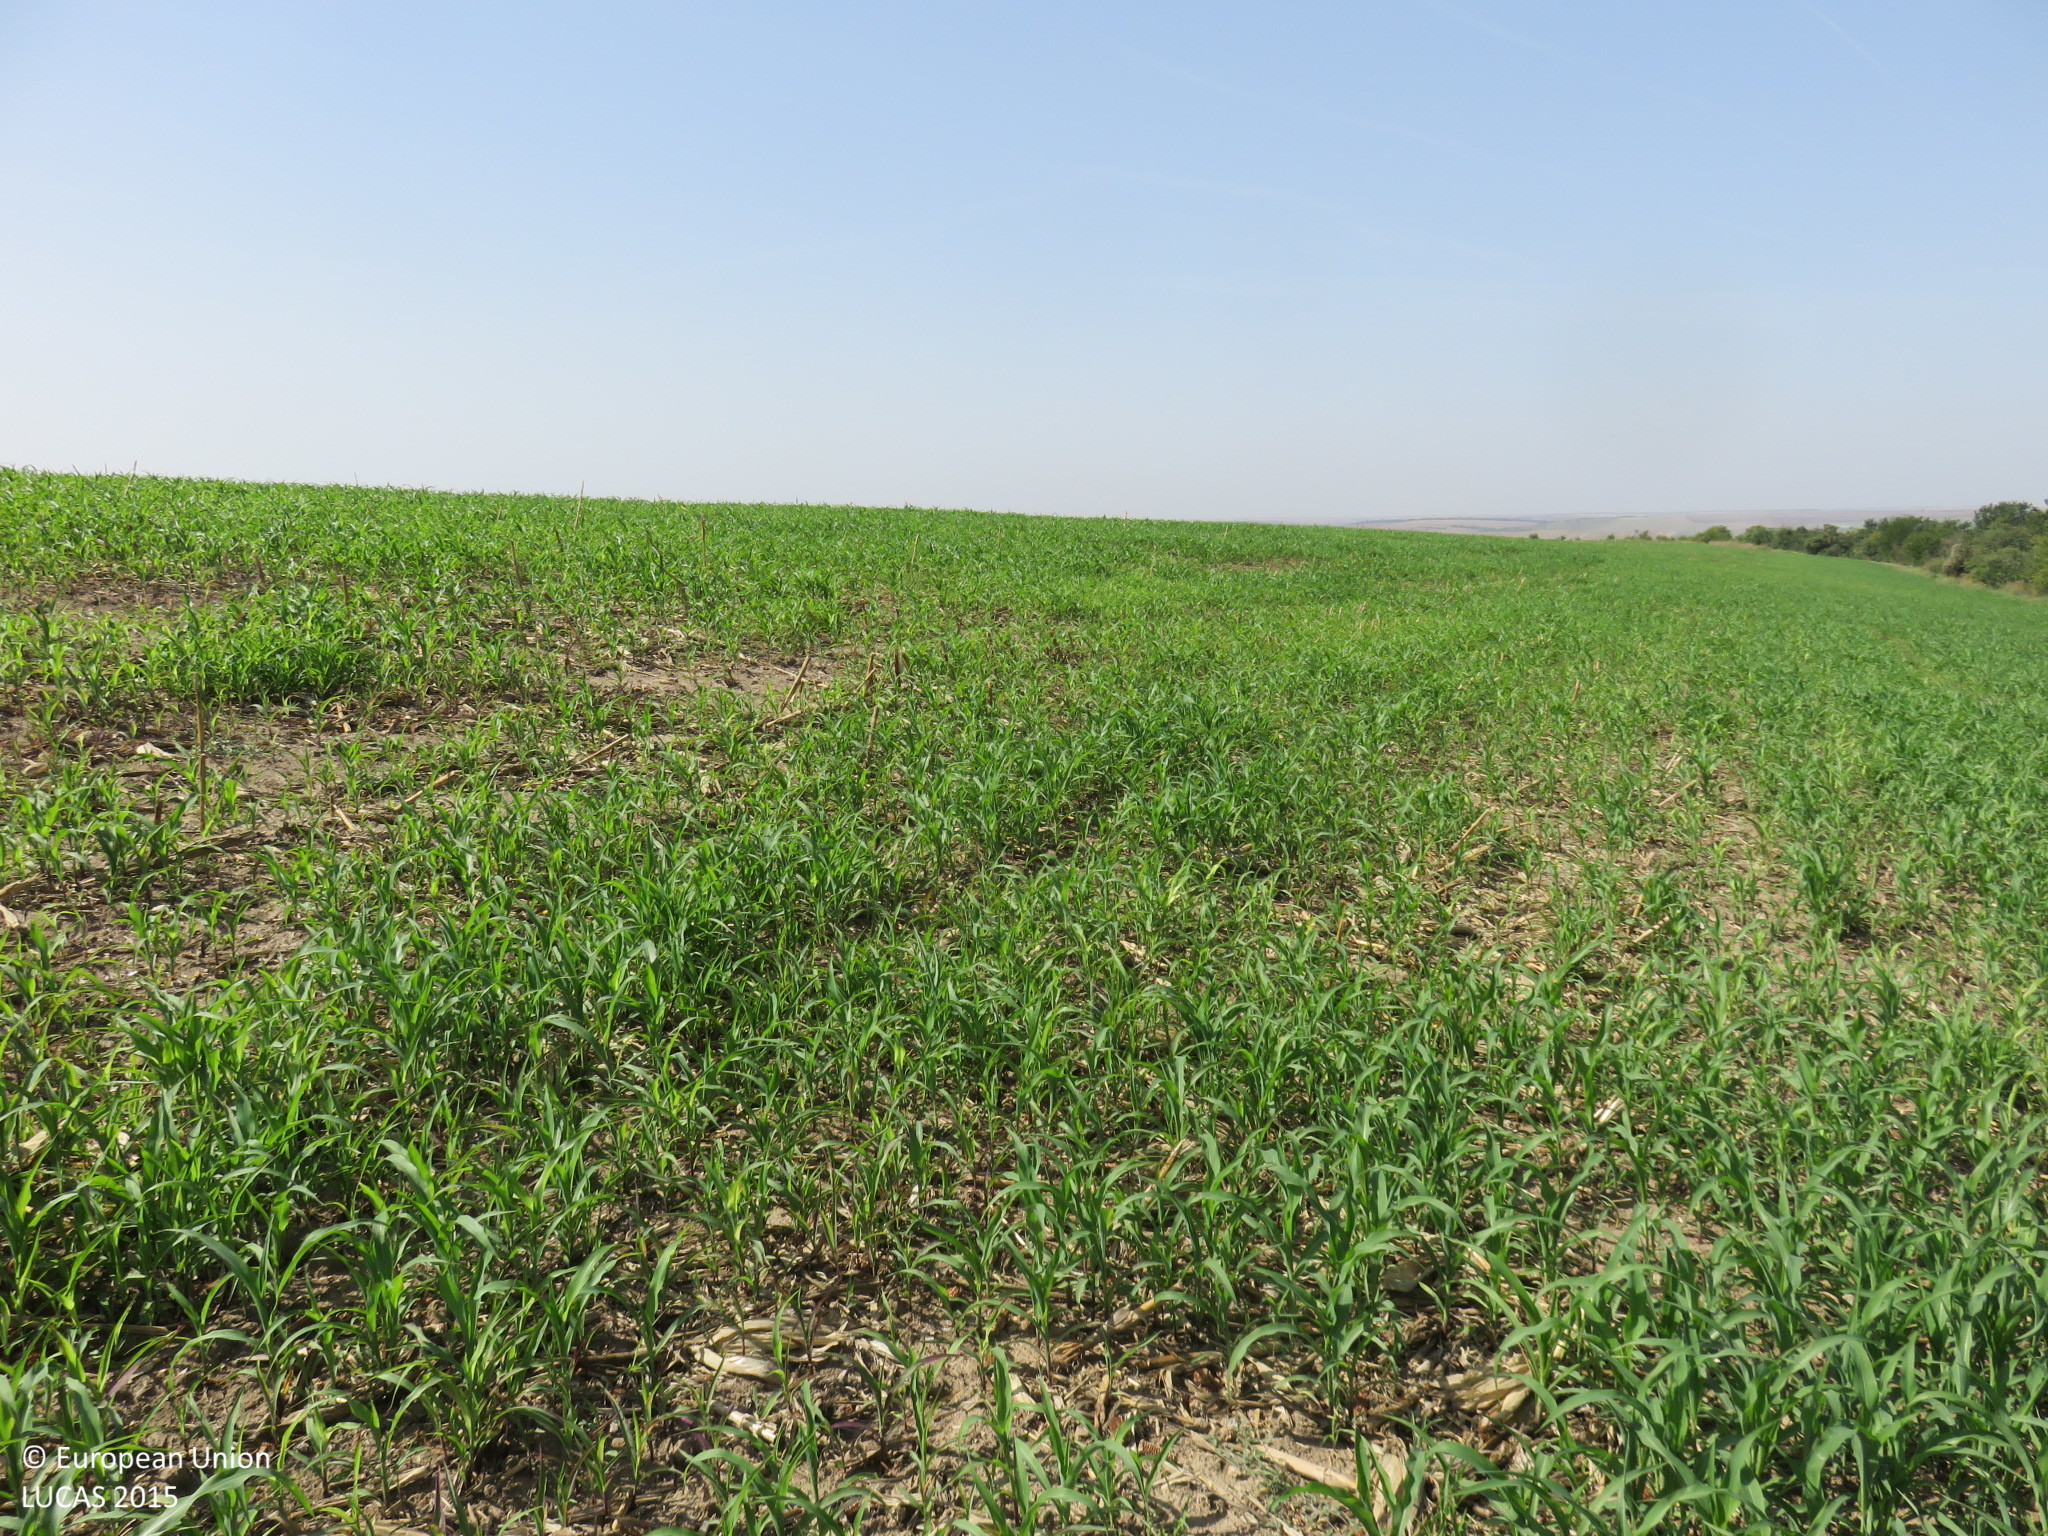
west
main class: Cropland
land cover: Maize
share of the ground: 25 - 50 %
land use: Agriculture (excluding fallow land and kitchen gardens)
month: September
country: BG
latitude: 43.5448
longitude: 24.6318
